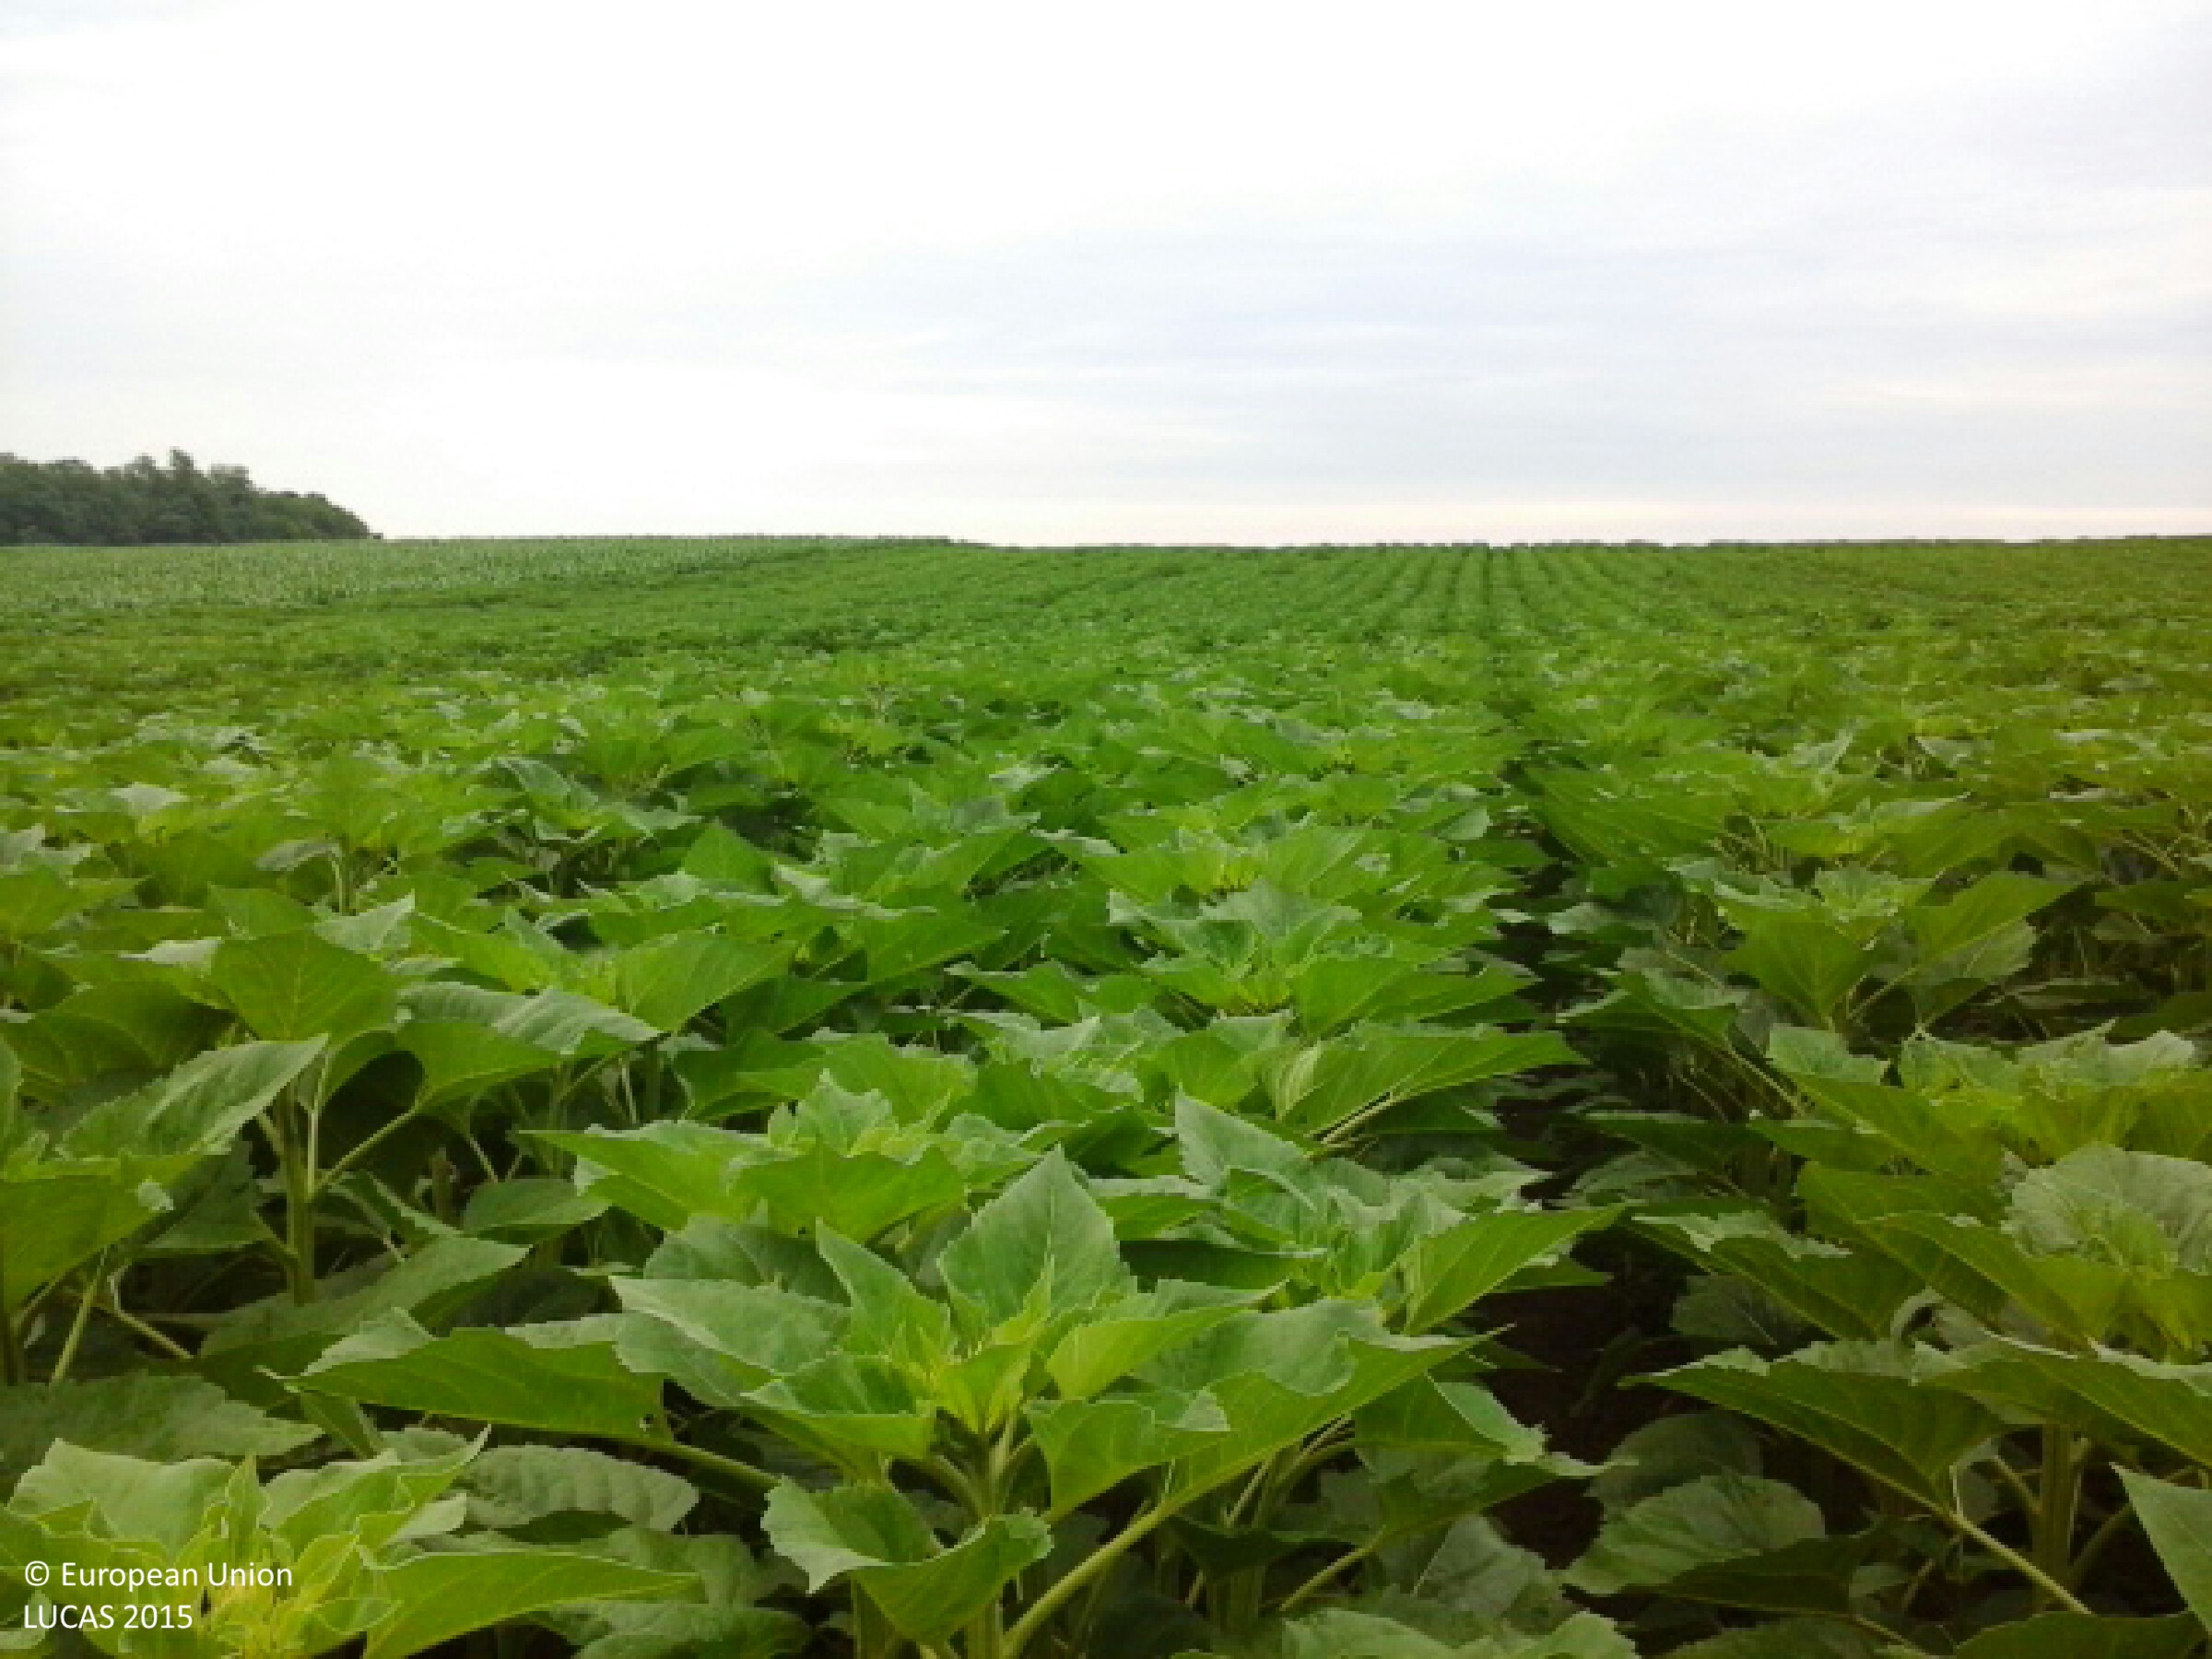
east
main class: Cropland
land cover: Sunflower
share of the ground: > 75 %
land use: Agriculture (excluding fallow land and kitchen gardens)
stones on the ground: < 10 %
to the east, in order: Sunflower; Tracks; Maize
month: June
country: HU
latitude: 48.1398
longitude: 21.5637
